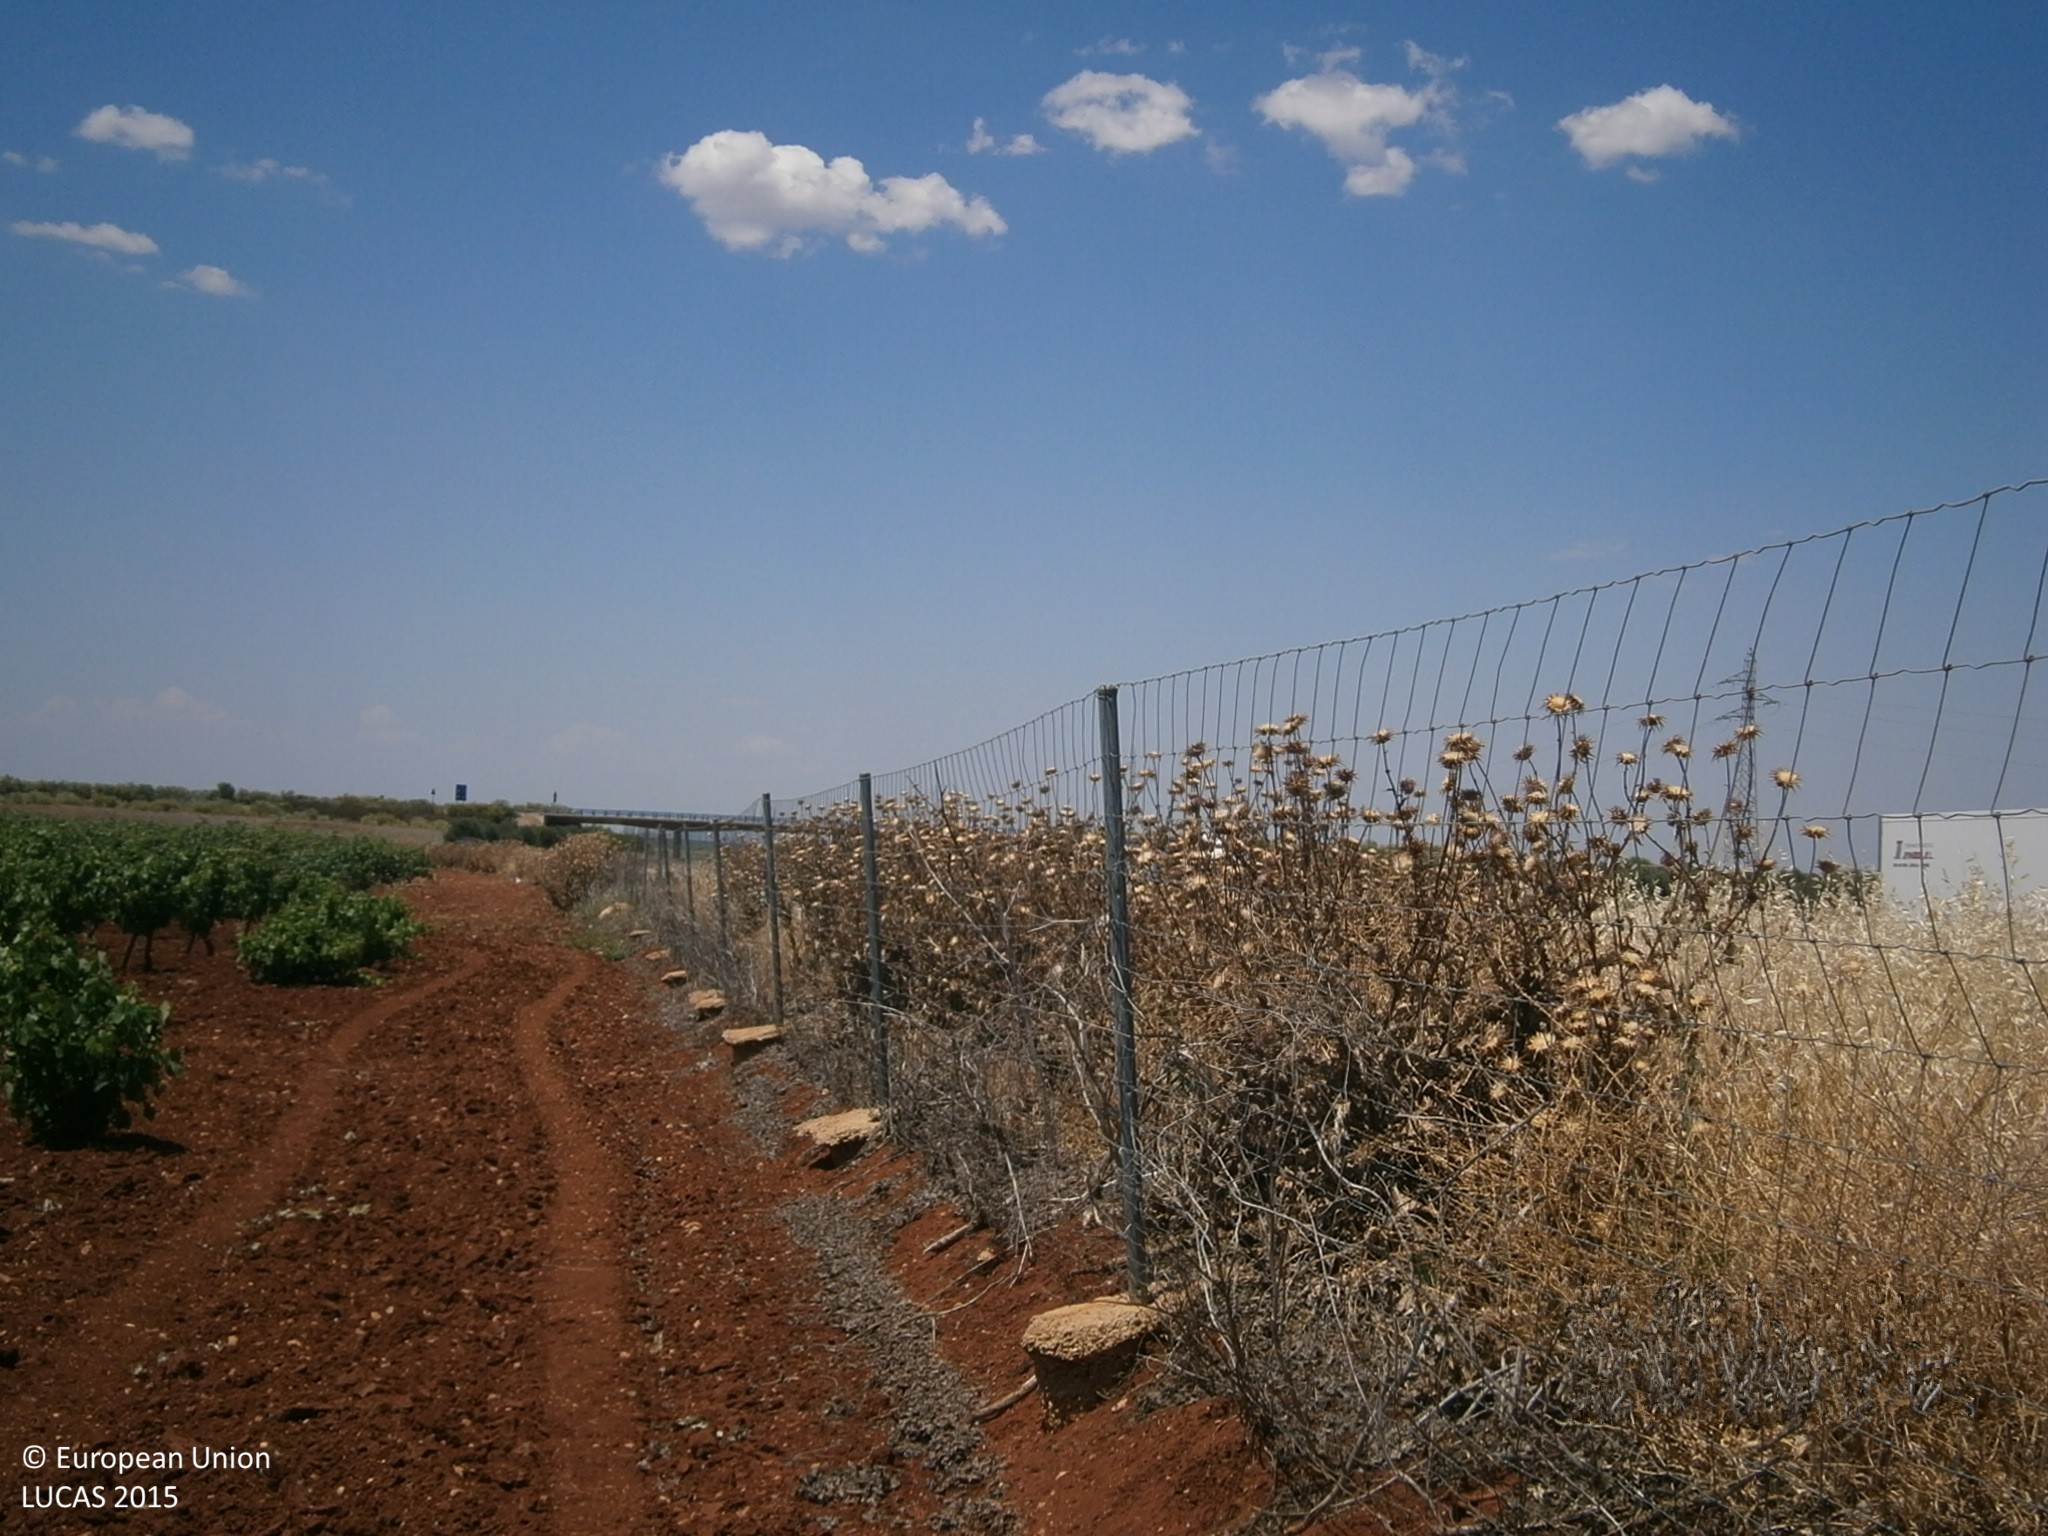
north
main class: Grassland
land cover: Spontaneously vegetated surfaces
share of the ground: > 75 %
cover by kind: herbaceous plants 100 %
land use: Road transport
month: June
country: ES
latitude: 38.5877
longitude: -6.3659
